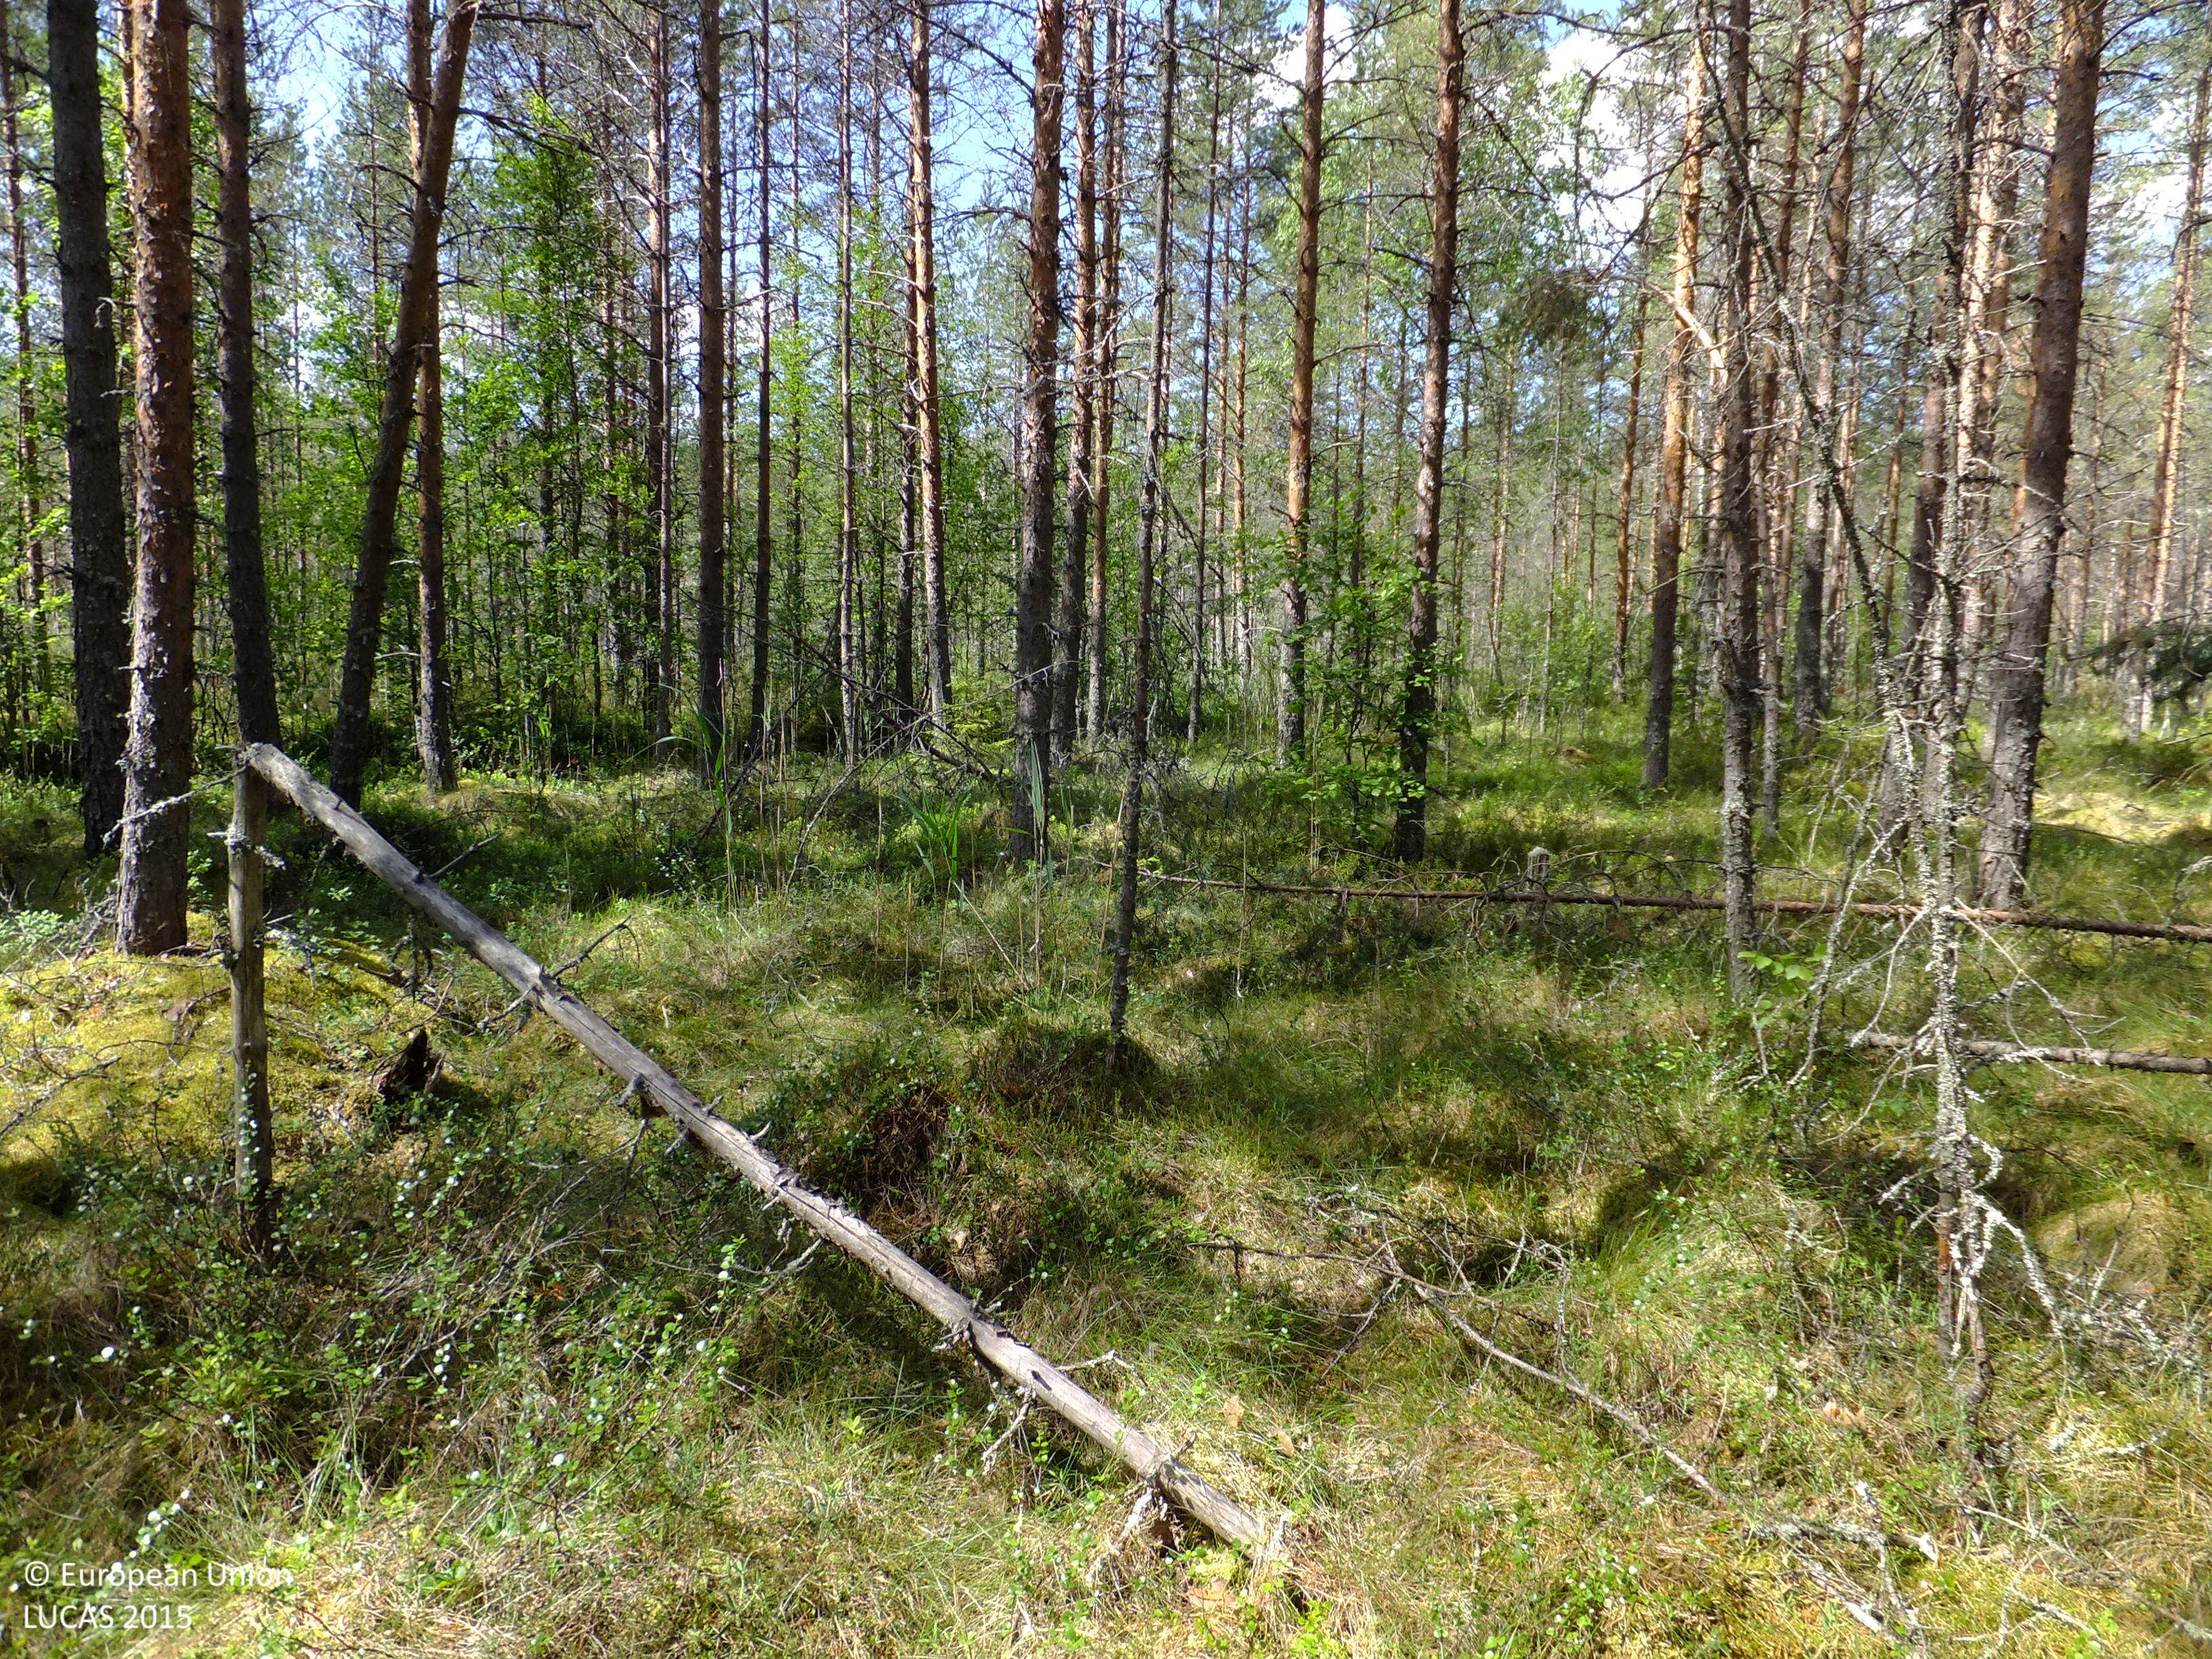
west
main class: Woodland
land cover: Pine dominated coniferous woodland
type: boreal forest
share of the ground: 50 - 75 %
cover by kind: coniferous forest trees 50 %, herbaceous plants 20 %, lichens and mosses 15 %, shrubs 10 %, broadleaved forest trees 5 %
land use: Forestry
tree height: > 5 m
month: July
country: FI
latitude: 63.2531
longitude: 24.6440
